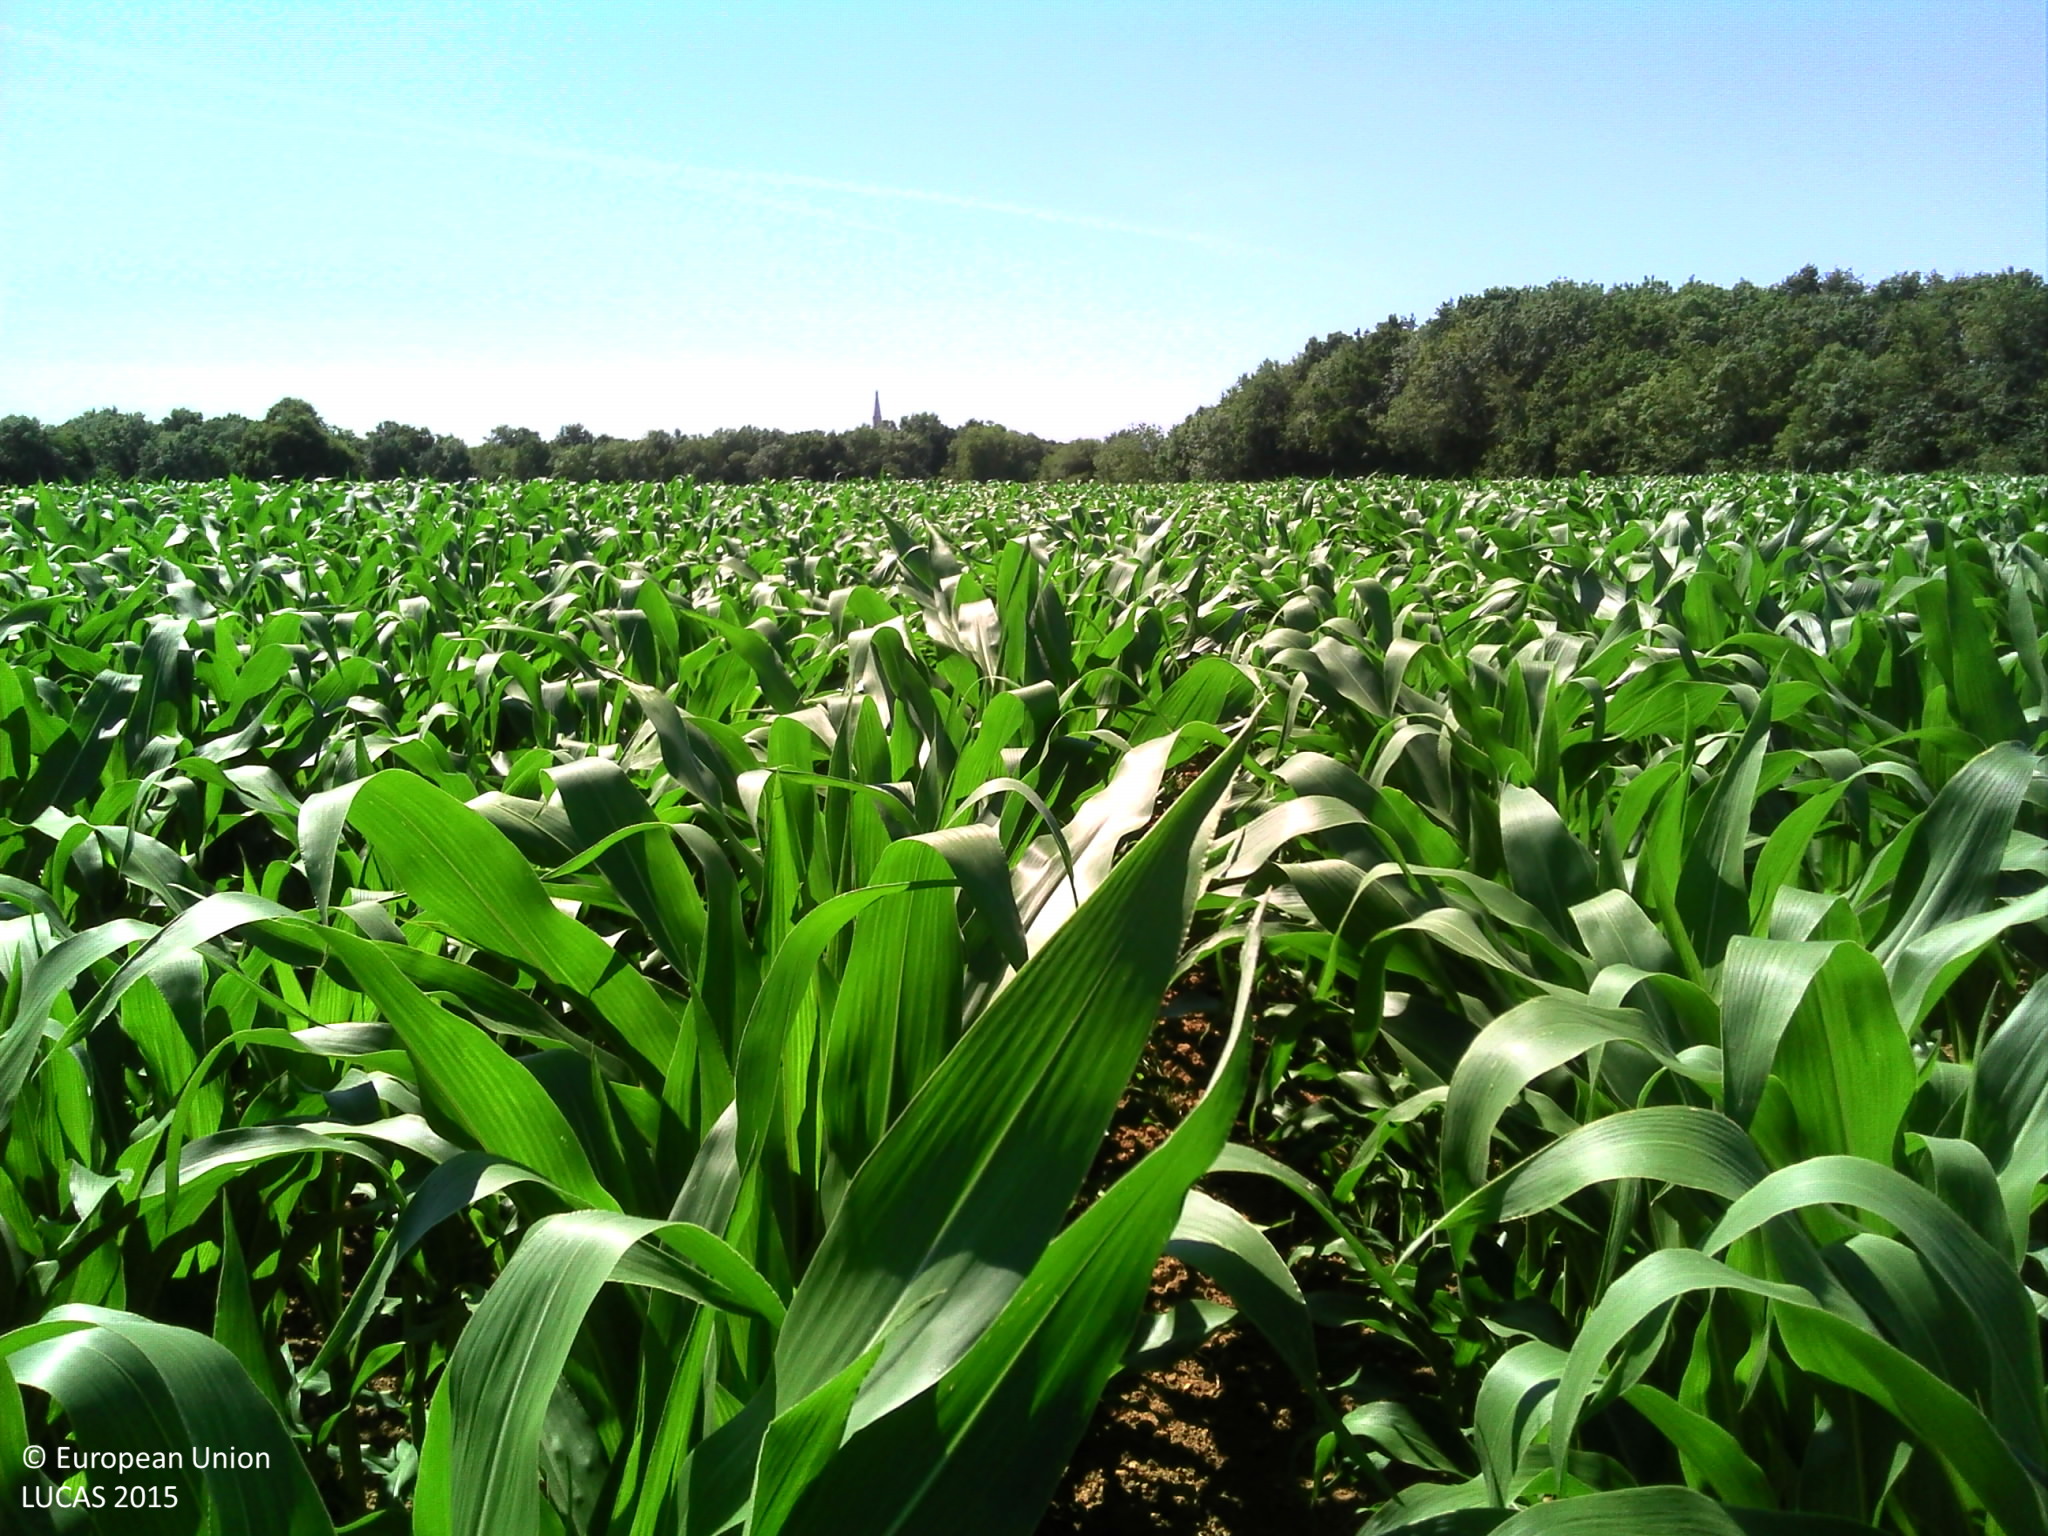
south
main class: Cropland
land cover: Maize
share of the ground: > 75 %
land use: Agriculture (excluding fallow land and kitchen gardens)
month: July
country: FR
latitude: 47.1776
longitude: -1.7216
